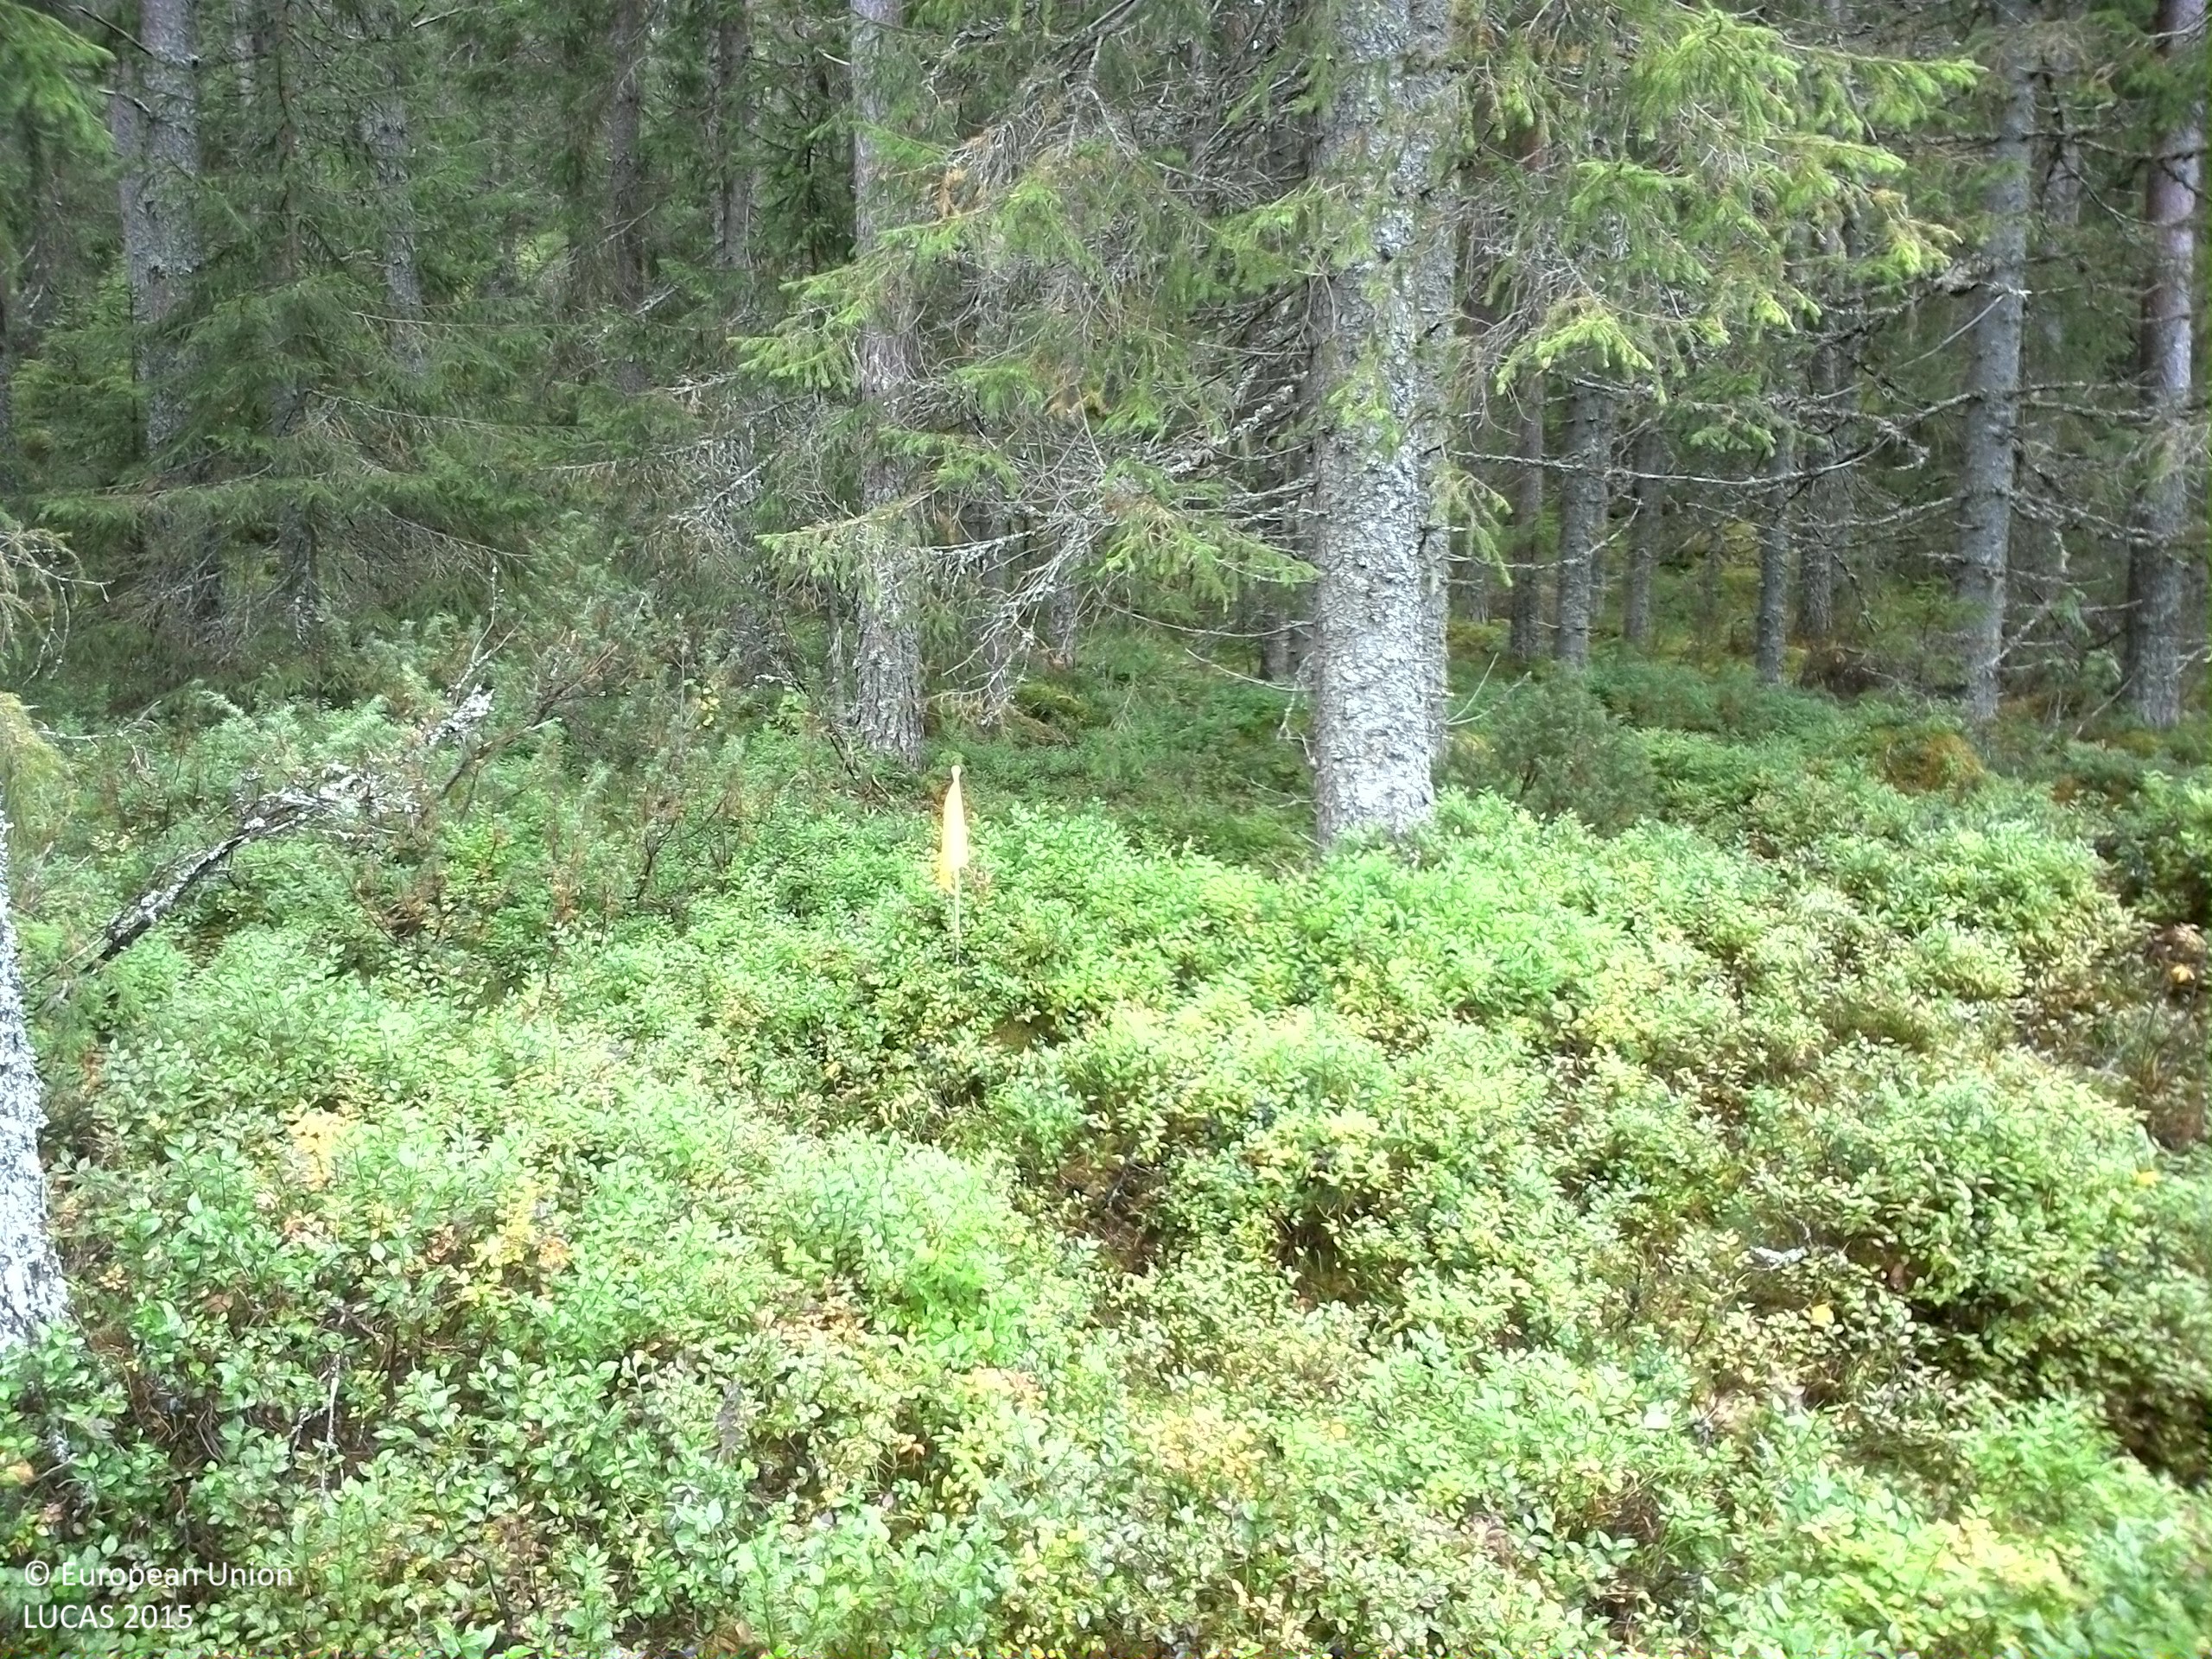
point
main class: Woodland
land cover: Spruce dominated coniferous woodland
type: boreal forest
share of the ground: 50 - 75 %
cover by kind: coniferous forest trees 60 %, shrubs 25 %, lichens and mosses 10 %, broadleaved forest trees 5 %
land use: Forestry
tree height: > 5 m
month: September
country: SE
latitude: 61.7101
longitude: 15.1848
